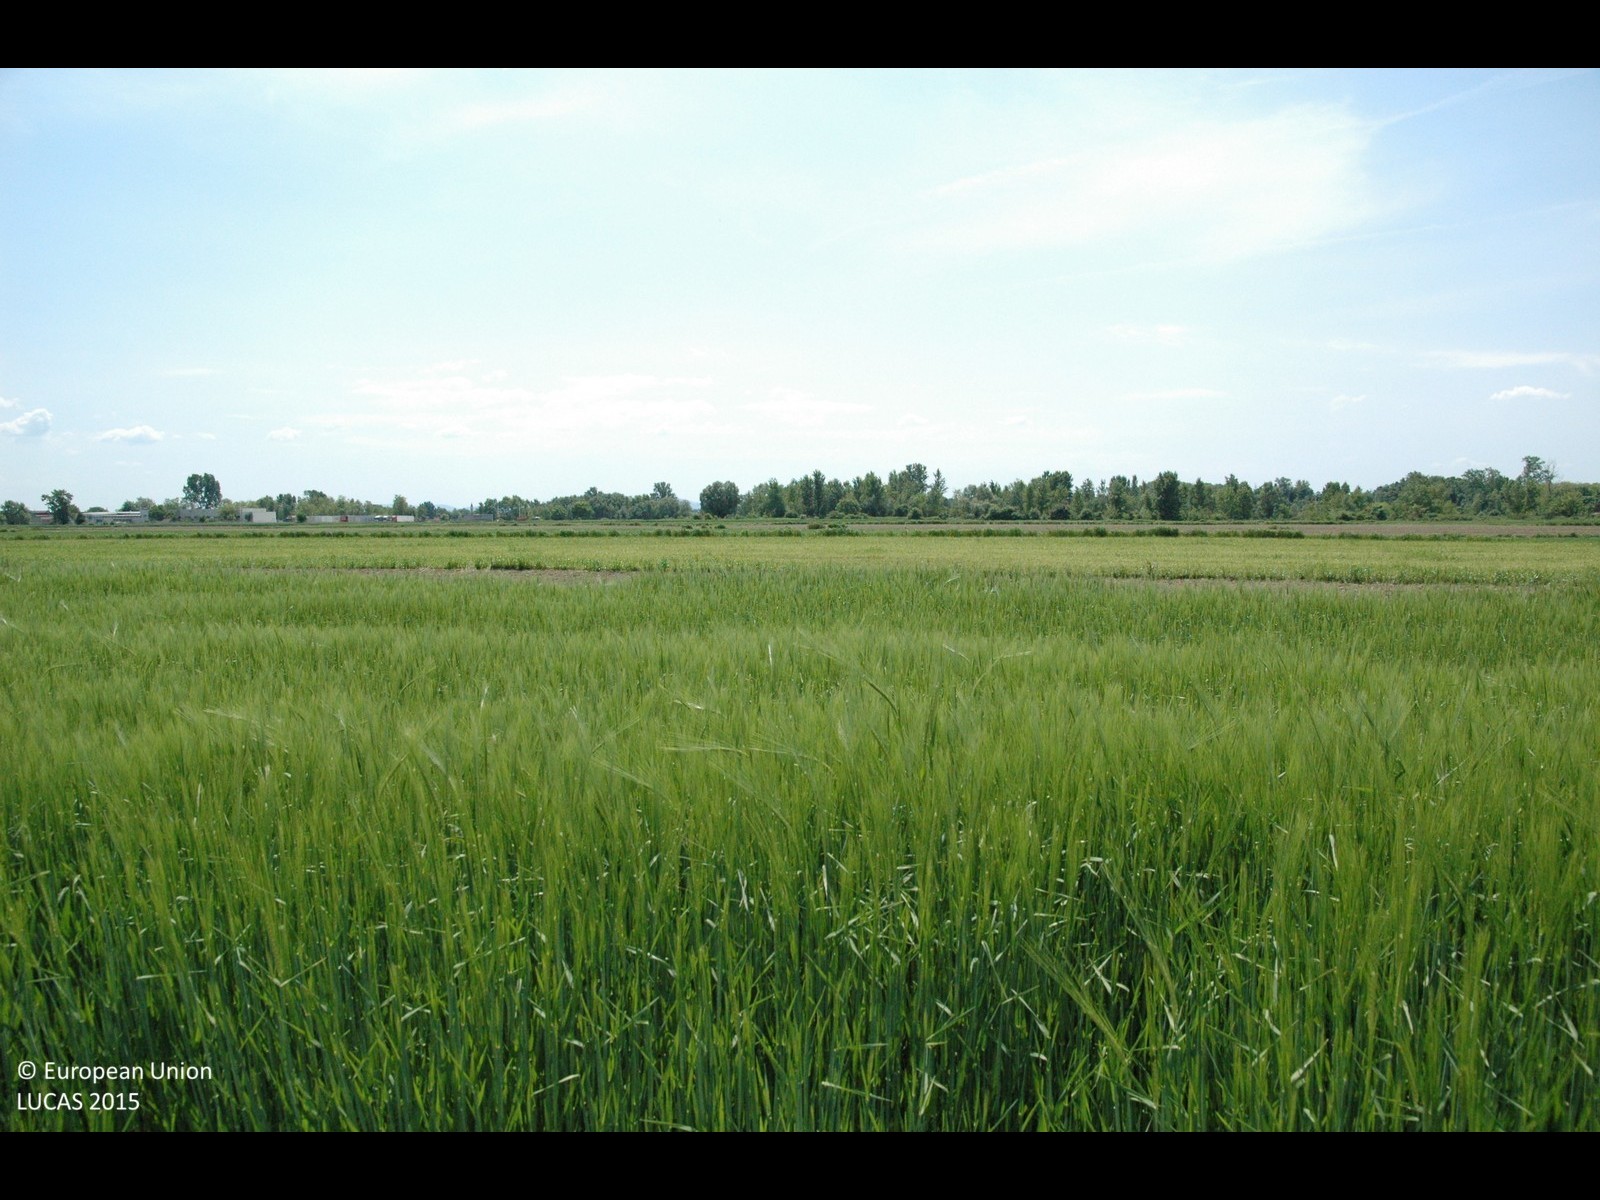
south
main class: Cropland
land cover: Common wheat
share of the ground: > 75 %
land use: Agriculture (excluding fallow land and kitchen gardens)
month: May
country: HR
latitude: 46.3429
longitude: 16.3538
